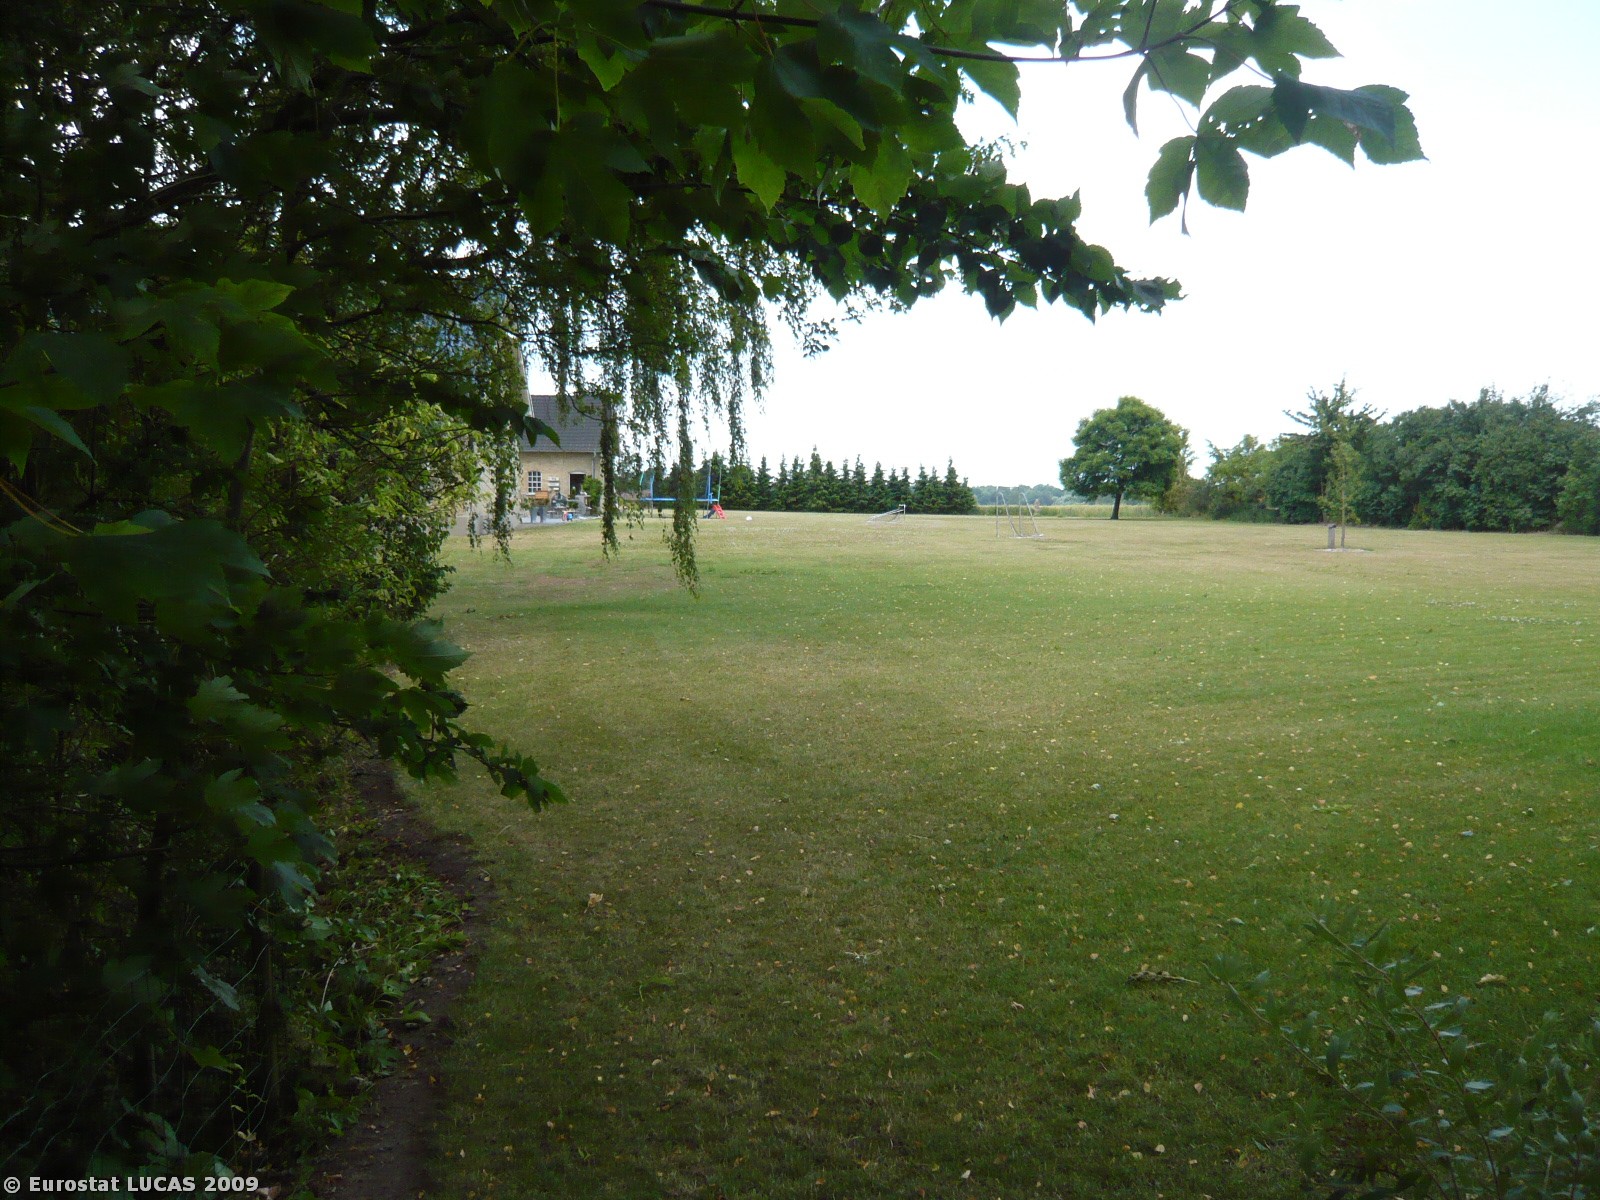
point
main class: Grassland
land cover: Grassland without tree/shrub cover
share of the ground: > 75 %
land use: Residential
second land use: Sport
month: July
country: DK
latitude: 55.5405
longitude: 10.1741
